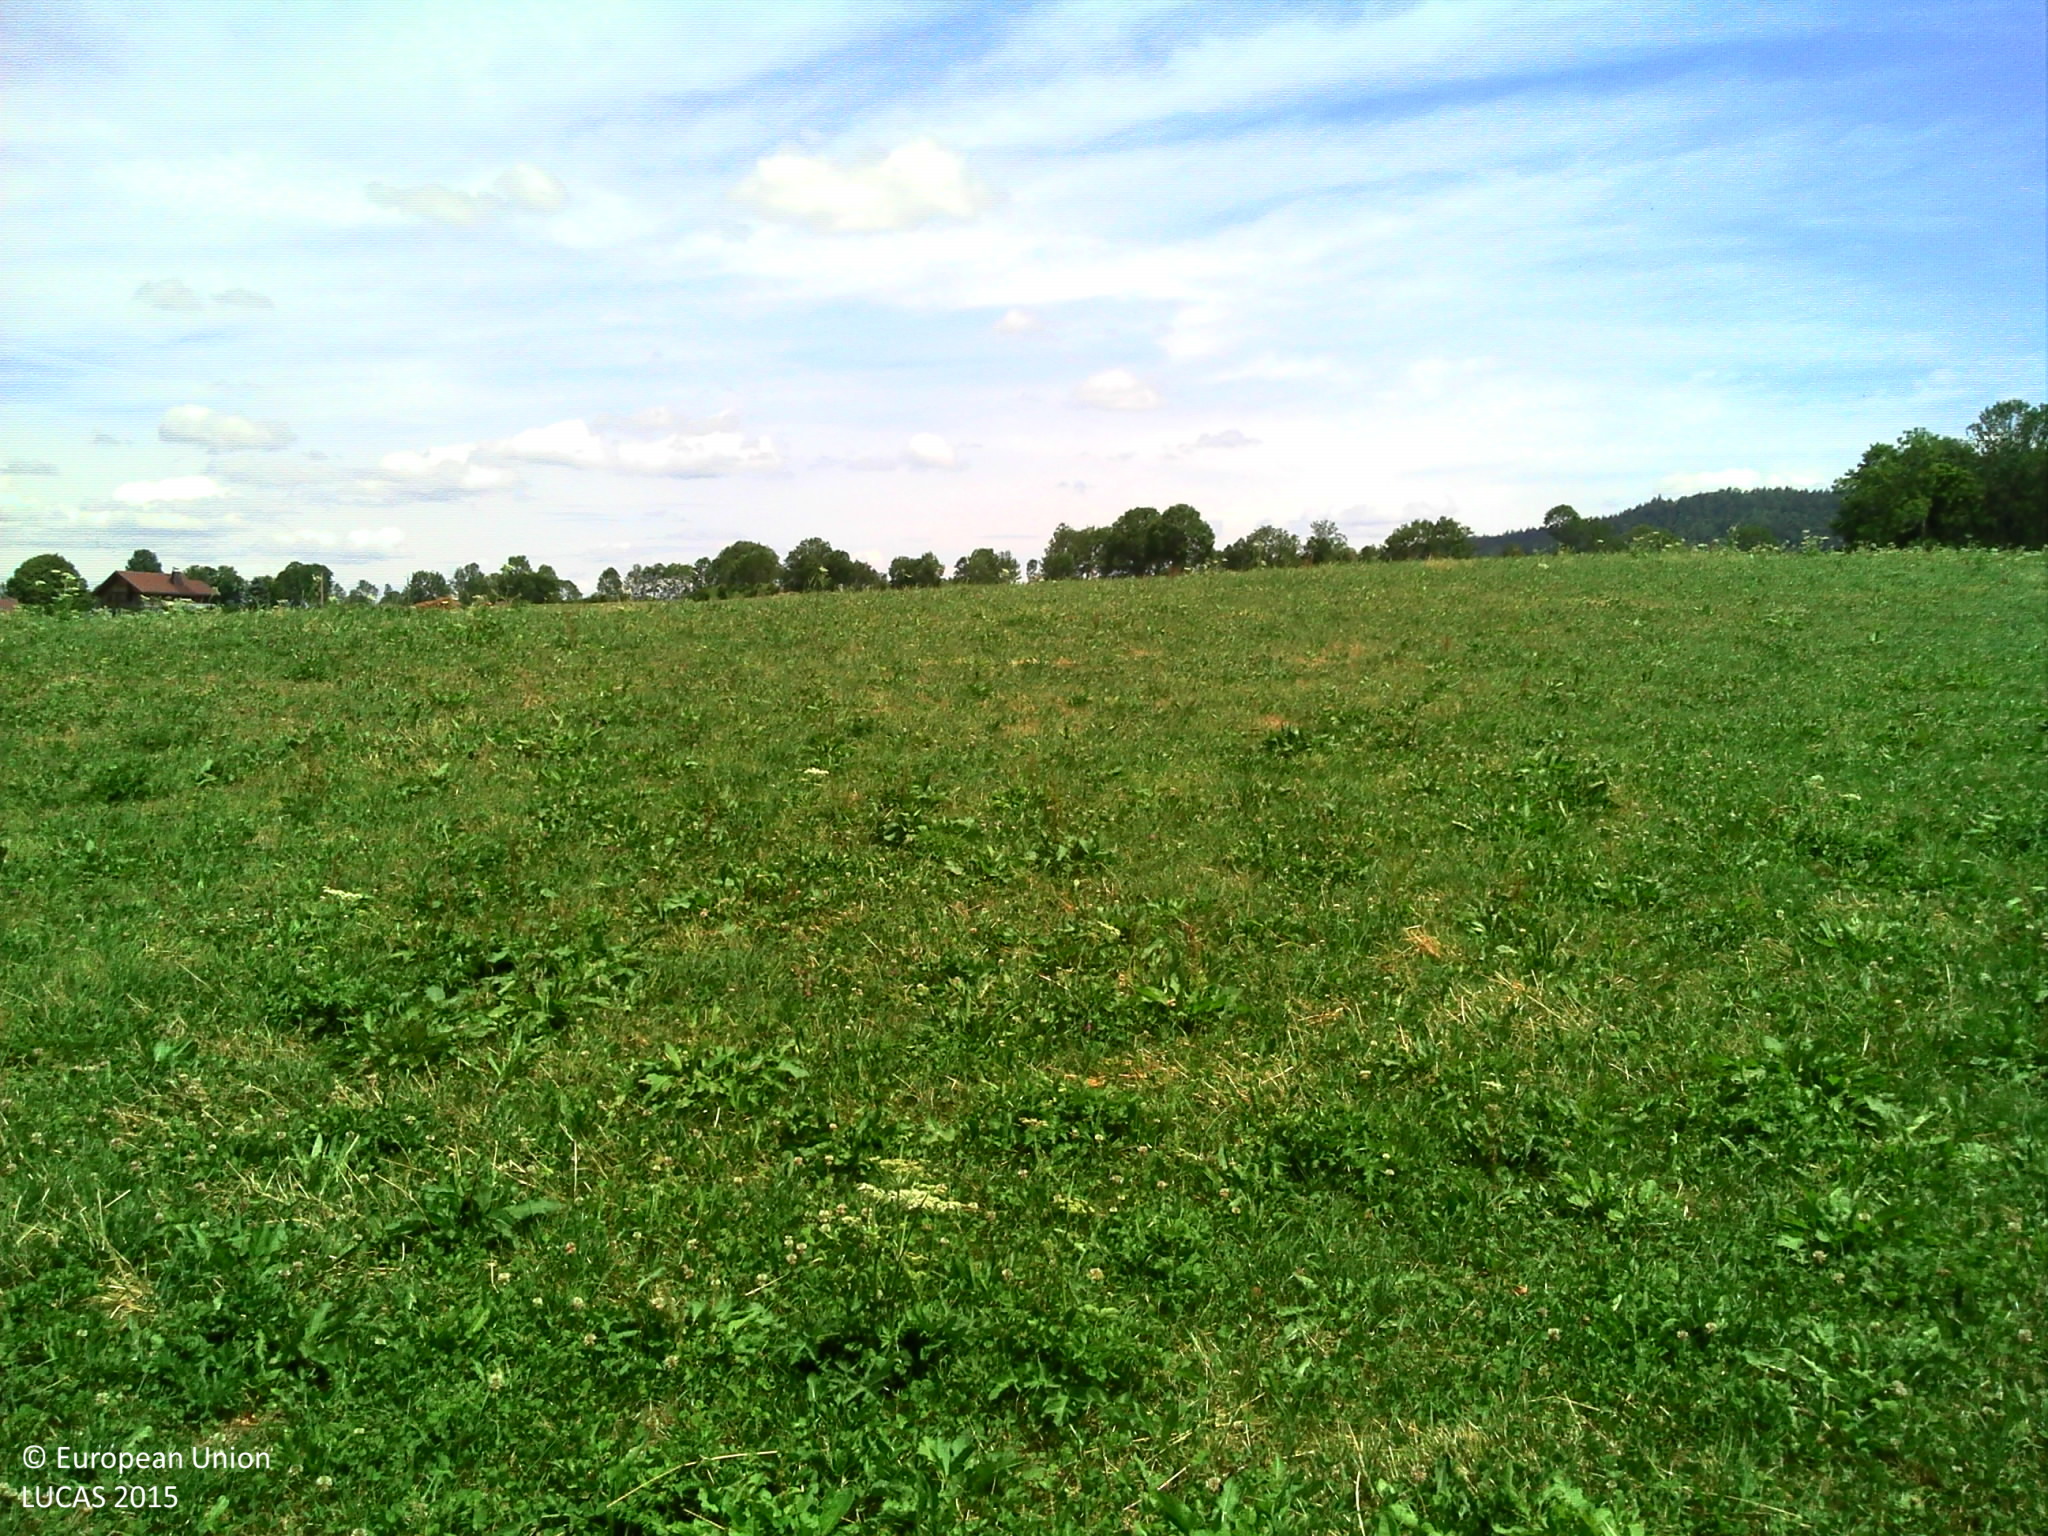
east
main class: Grassland
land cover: Grassland without tree/shrub cover
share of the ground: > 75 %
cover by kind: herbaceous plants 100 %
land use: Agriculture (excluding fallow land and kitchen gardens)
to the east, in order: Grassland without tree/shrub cover
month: July
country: FR
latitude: 46.7305
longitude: 6.0900
